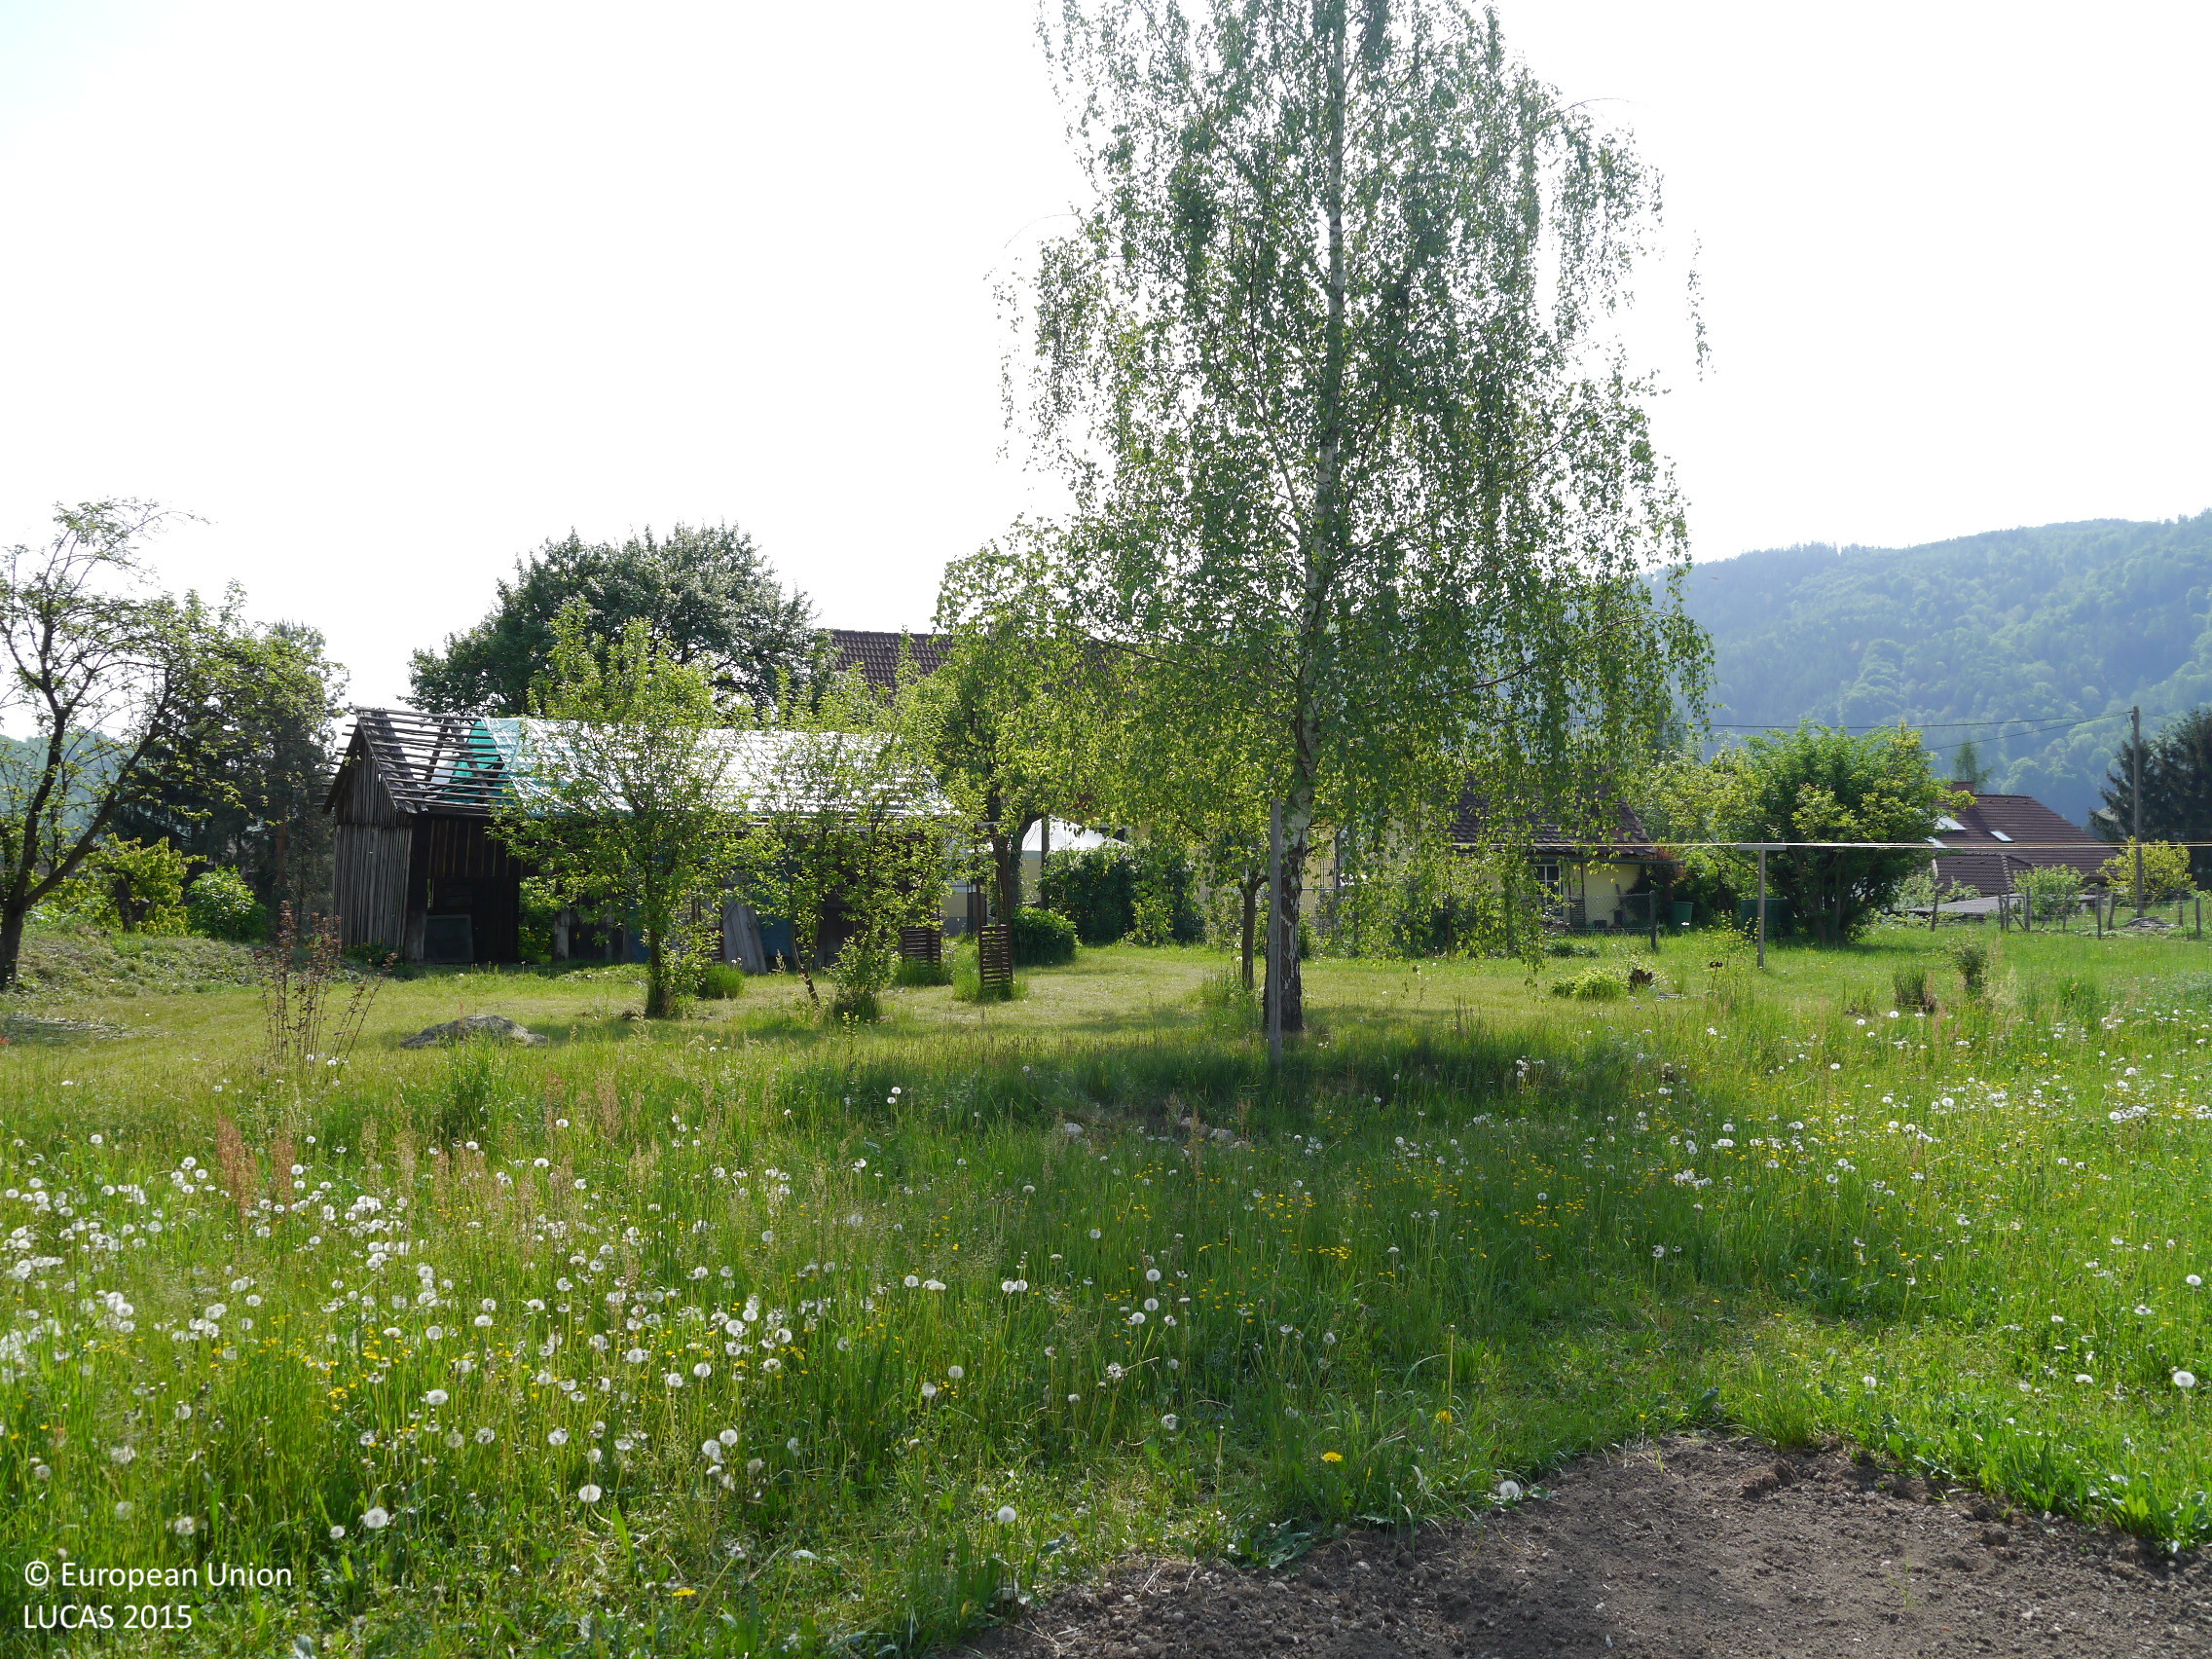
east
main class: Cropland
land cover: Other fresh vegetables
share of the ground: 50 - 75 %
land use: Kitchen garden
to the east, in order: Other fresh vegetables; Grassland without tree/shrub cover; Other fruit trees and berries; Artificial constructions in urban areas; Other fruit trees and berries; Artificial constructions; Railways; Artificial constructions; Grassland without tree/shrub cover; Maize; Grassland without tree/shrub cover
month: May
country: AT
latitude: 47.1202
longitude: 15.3379
